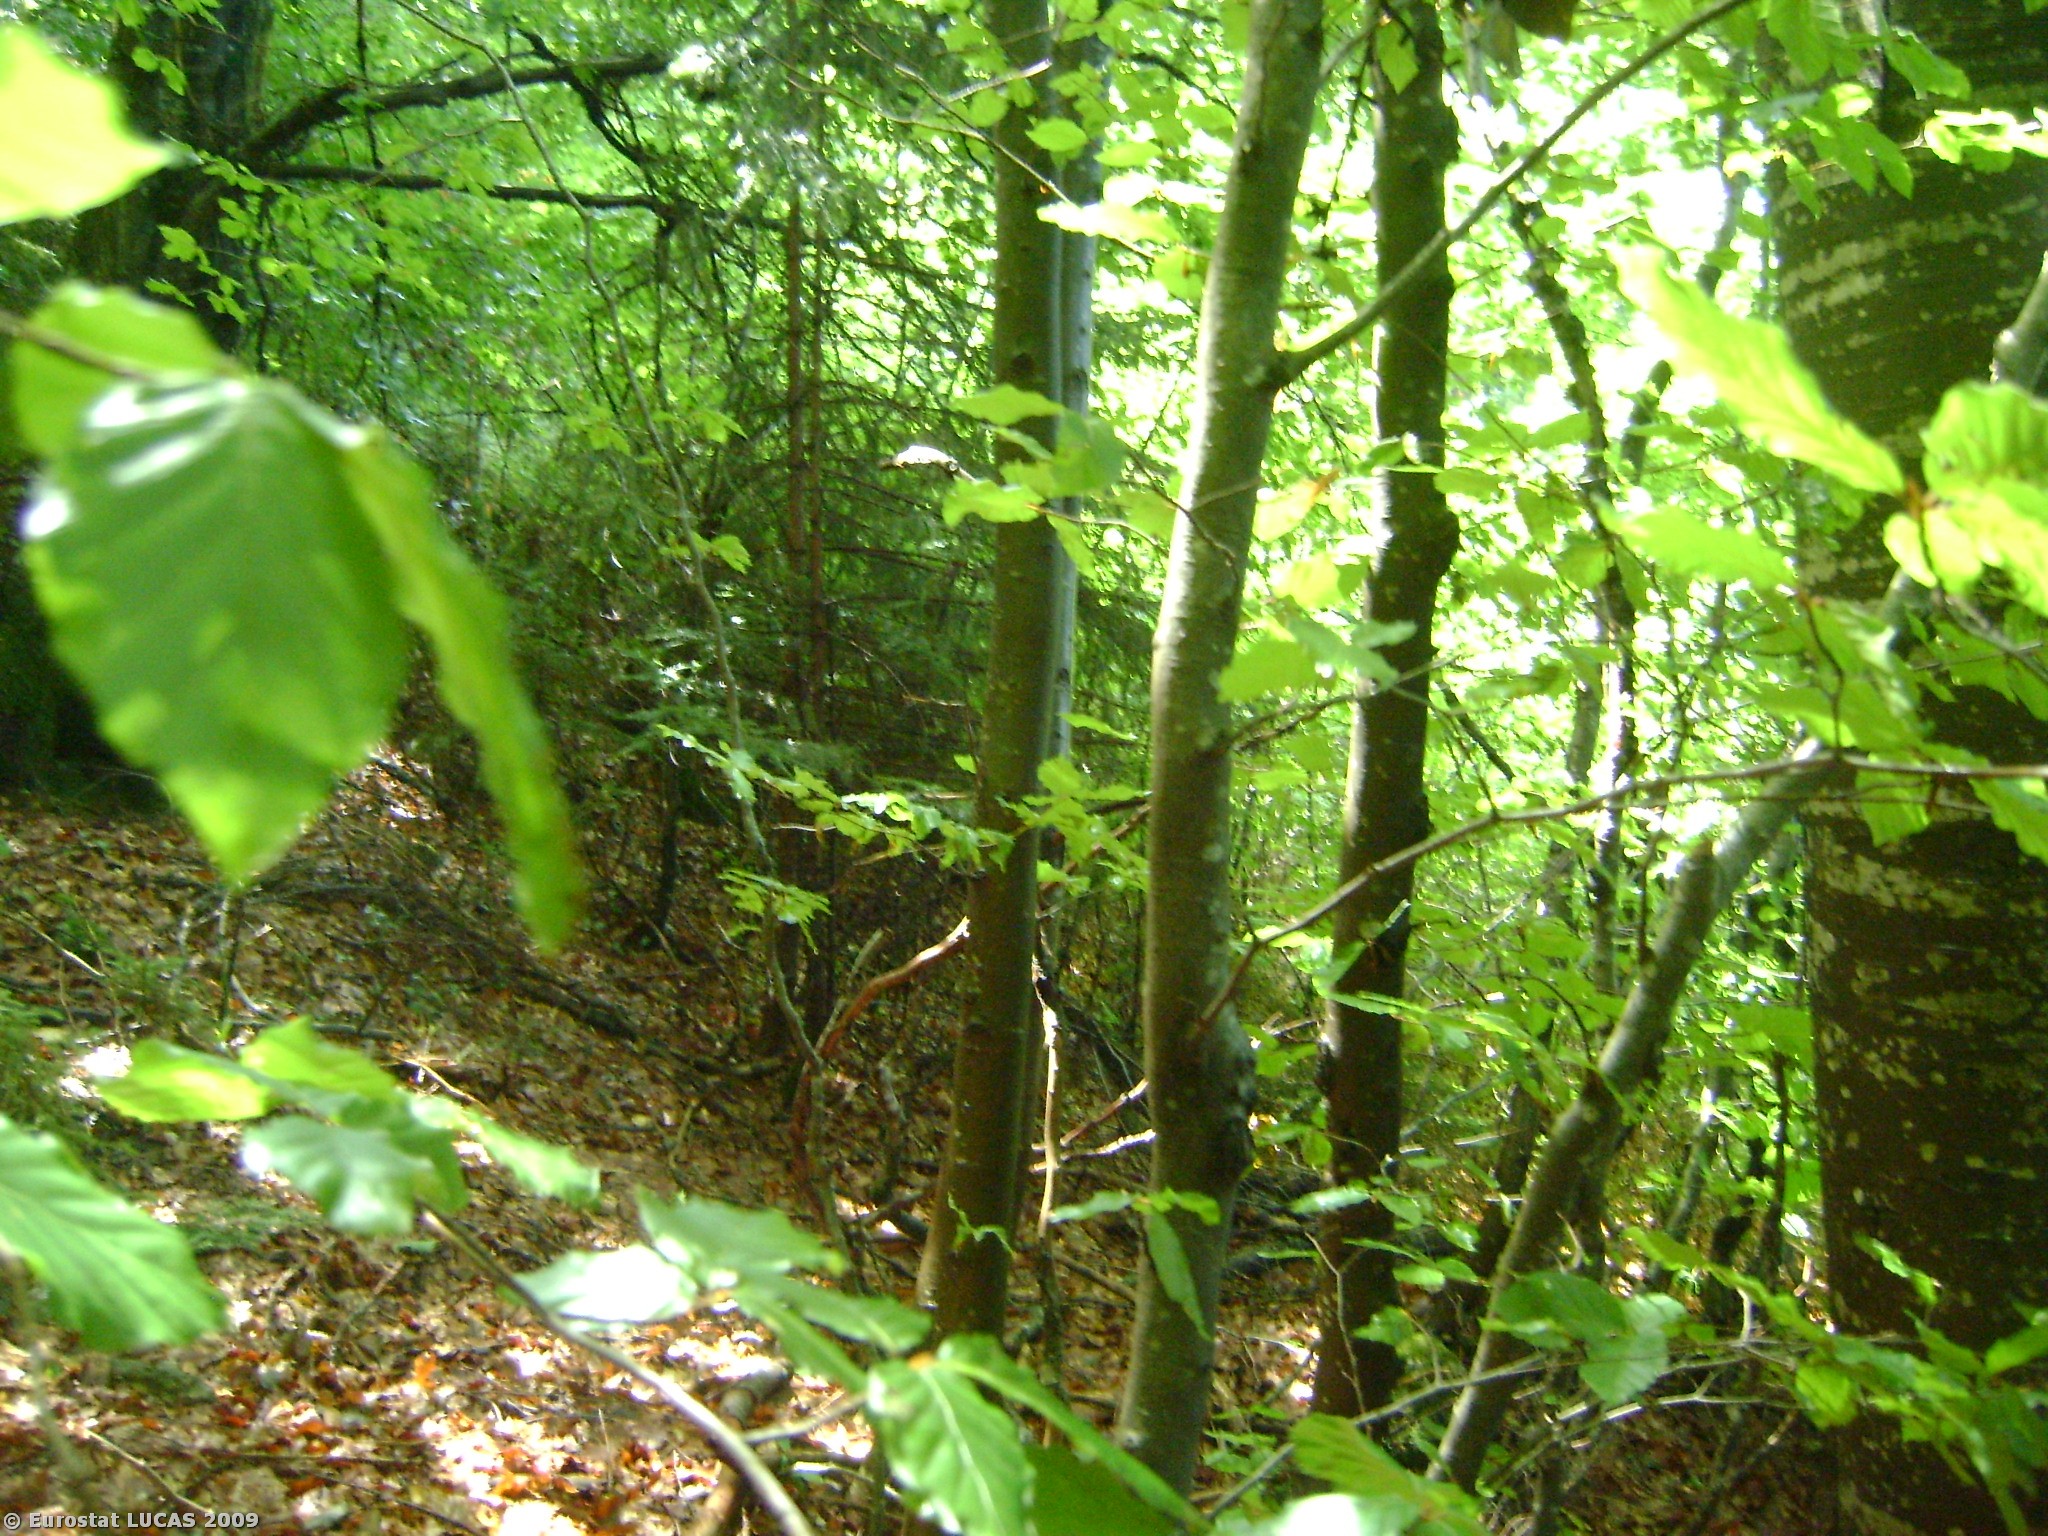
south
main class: Woodland
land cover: Broadleaved woodland
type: beech forest
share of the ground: > 75 %
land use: Forestry
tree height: > 5 m
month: August
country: AT
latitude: 47.3051
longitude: 9.6697
